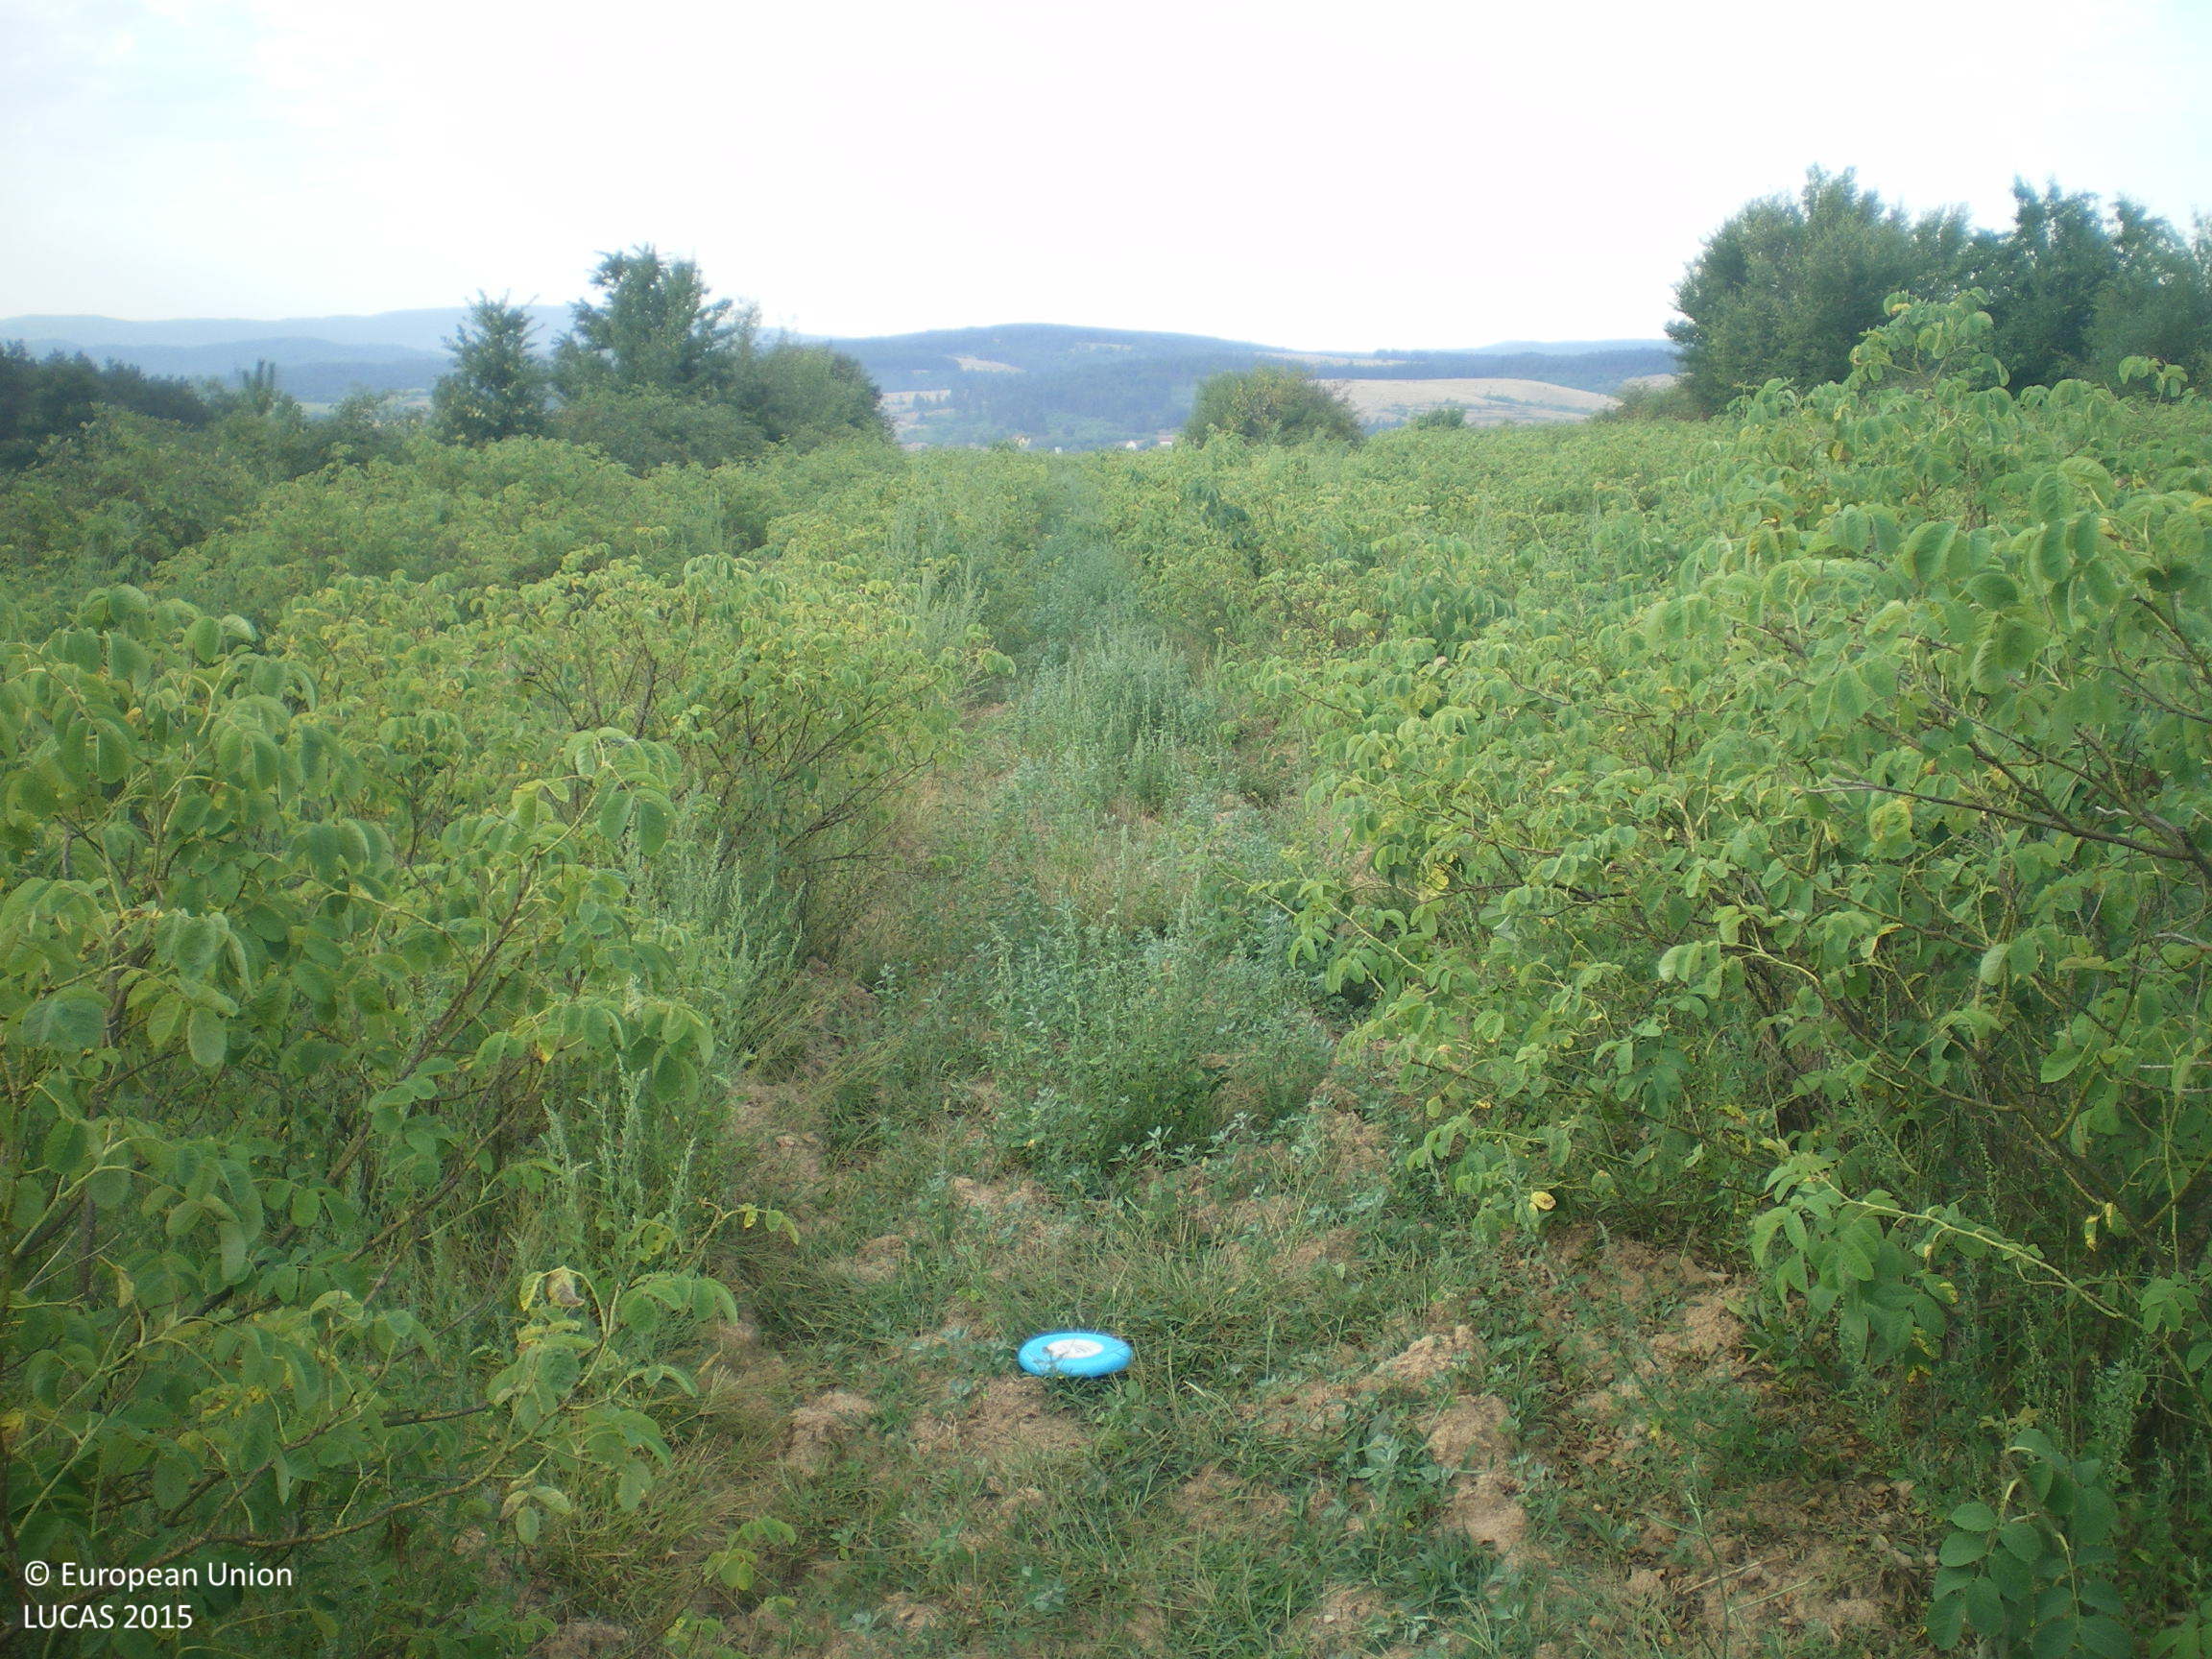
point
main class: Cropland
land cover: Permanent industrial crops
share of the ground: 50 - 75 %
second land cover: Spontaneously vegetated surfaces
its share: 25 - 50 %
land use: Agriculture (excluding fallow land and kitchen gardens)
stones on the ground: < 10 %
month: August
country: BG
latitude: 42.5829
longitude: 25.3102
